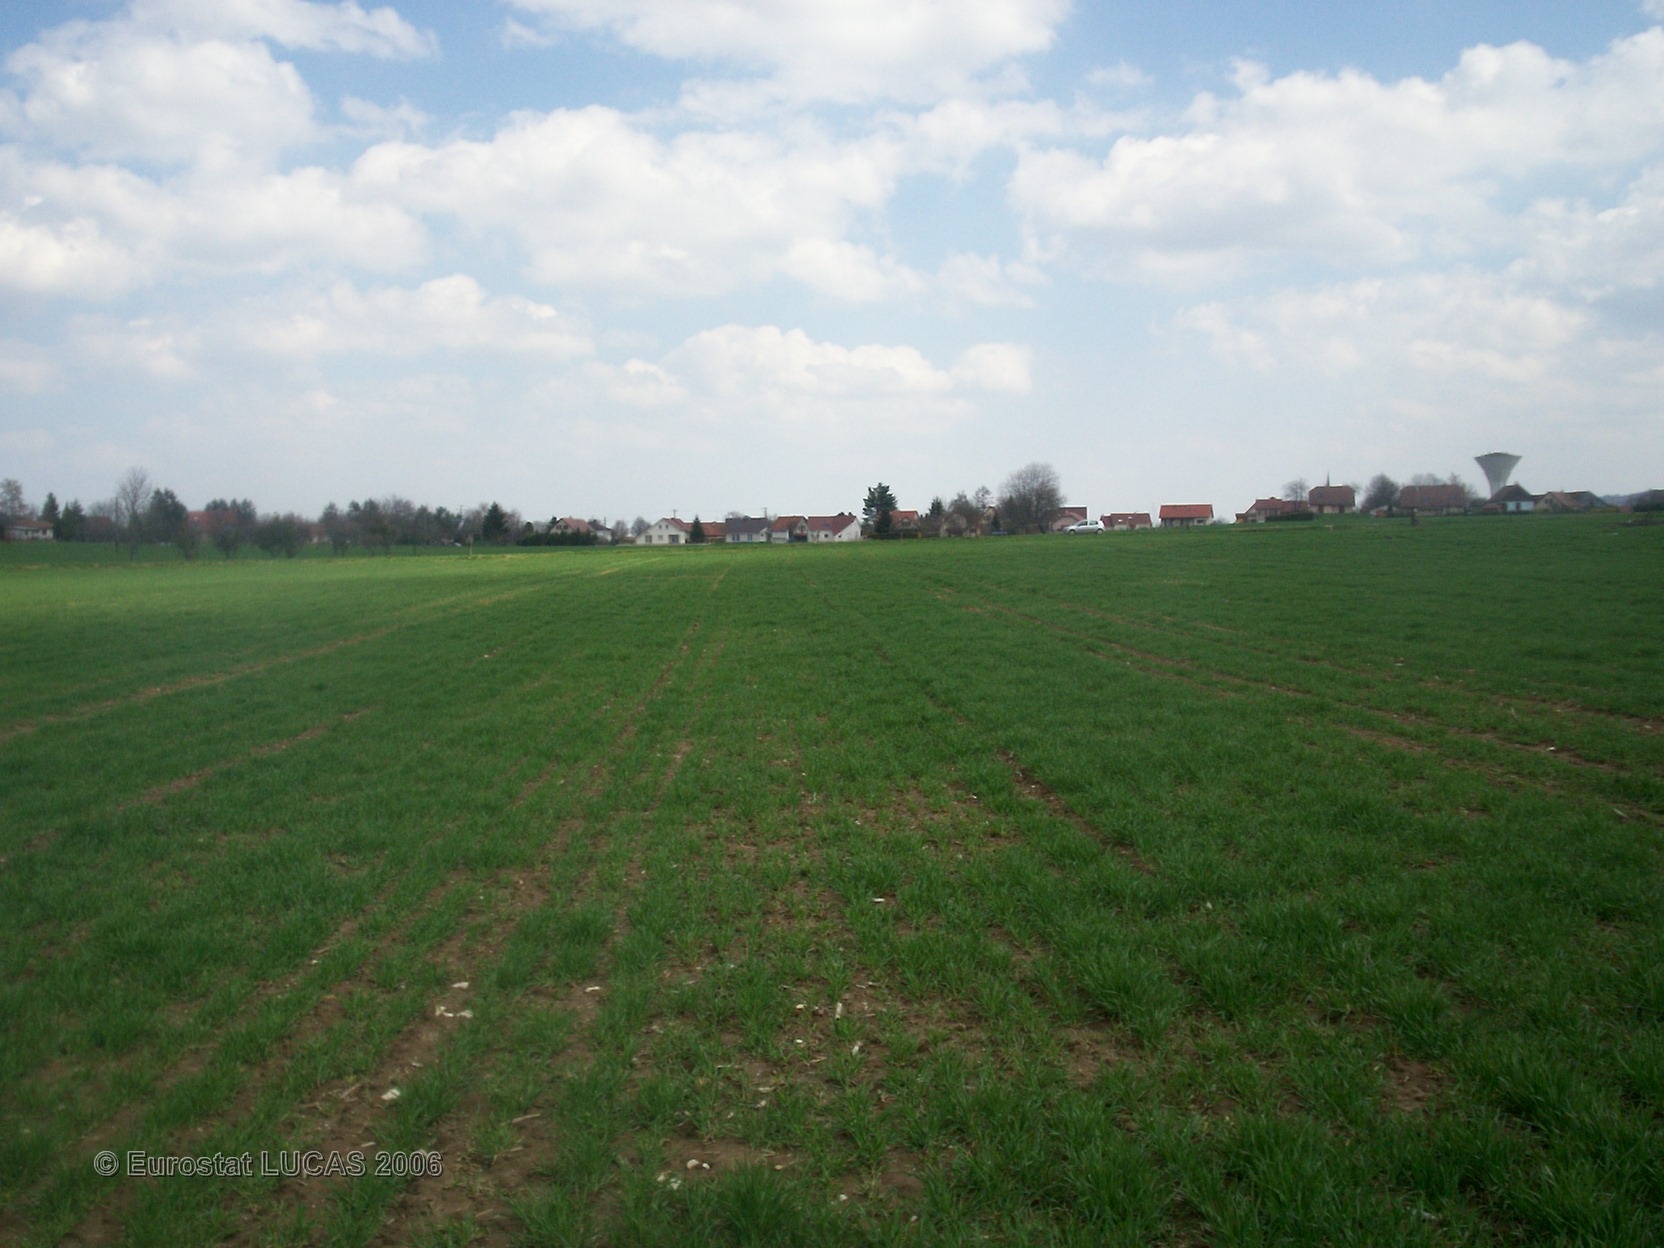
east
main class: Cropland
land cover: Barley
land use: Agriculture (excluding fallow land and kitchen gardens)
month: April
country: FR
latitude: 47.3856
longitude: 6.8359
